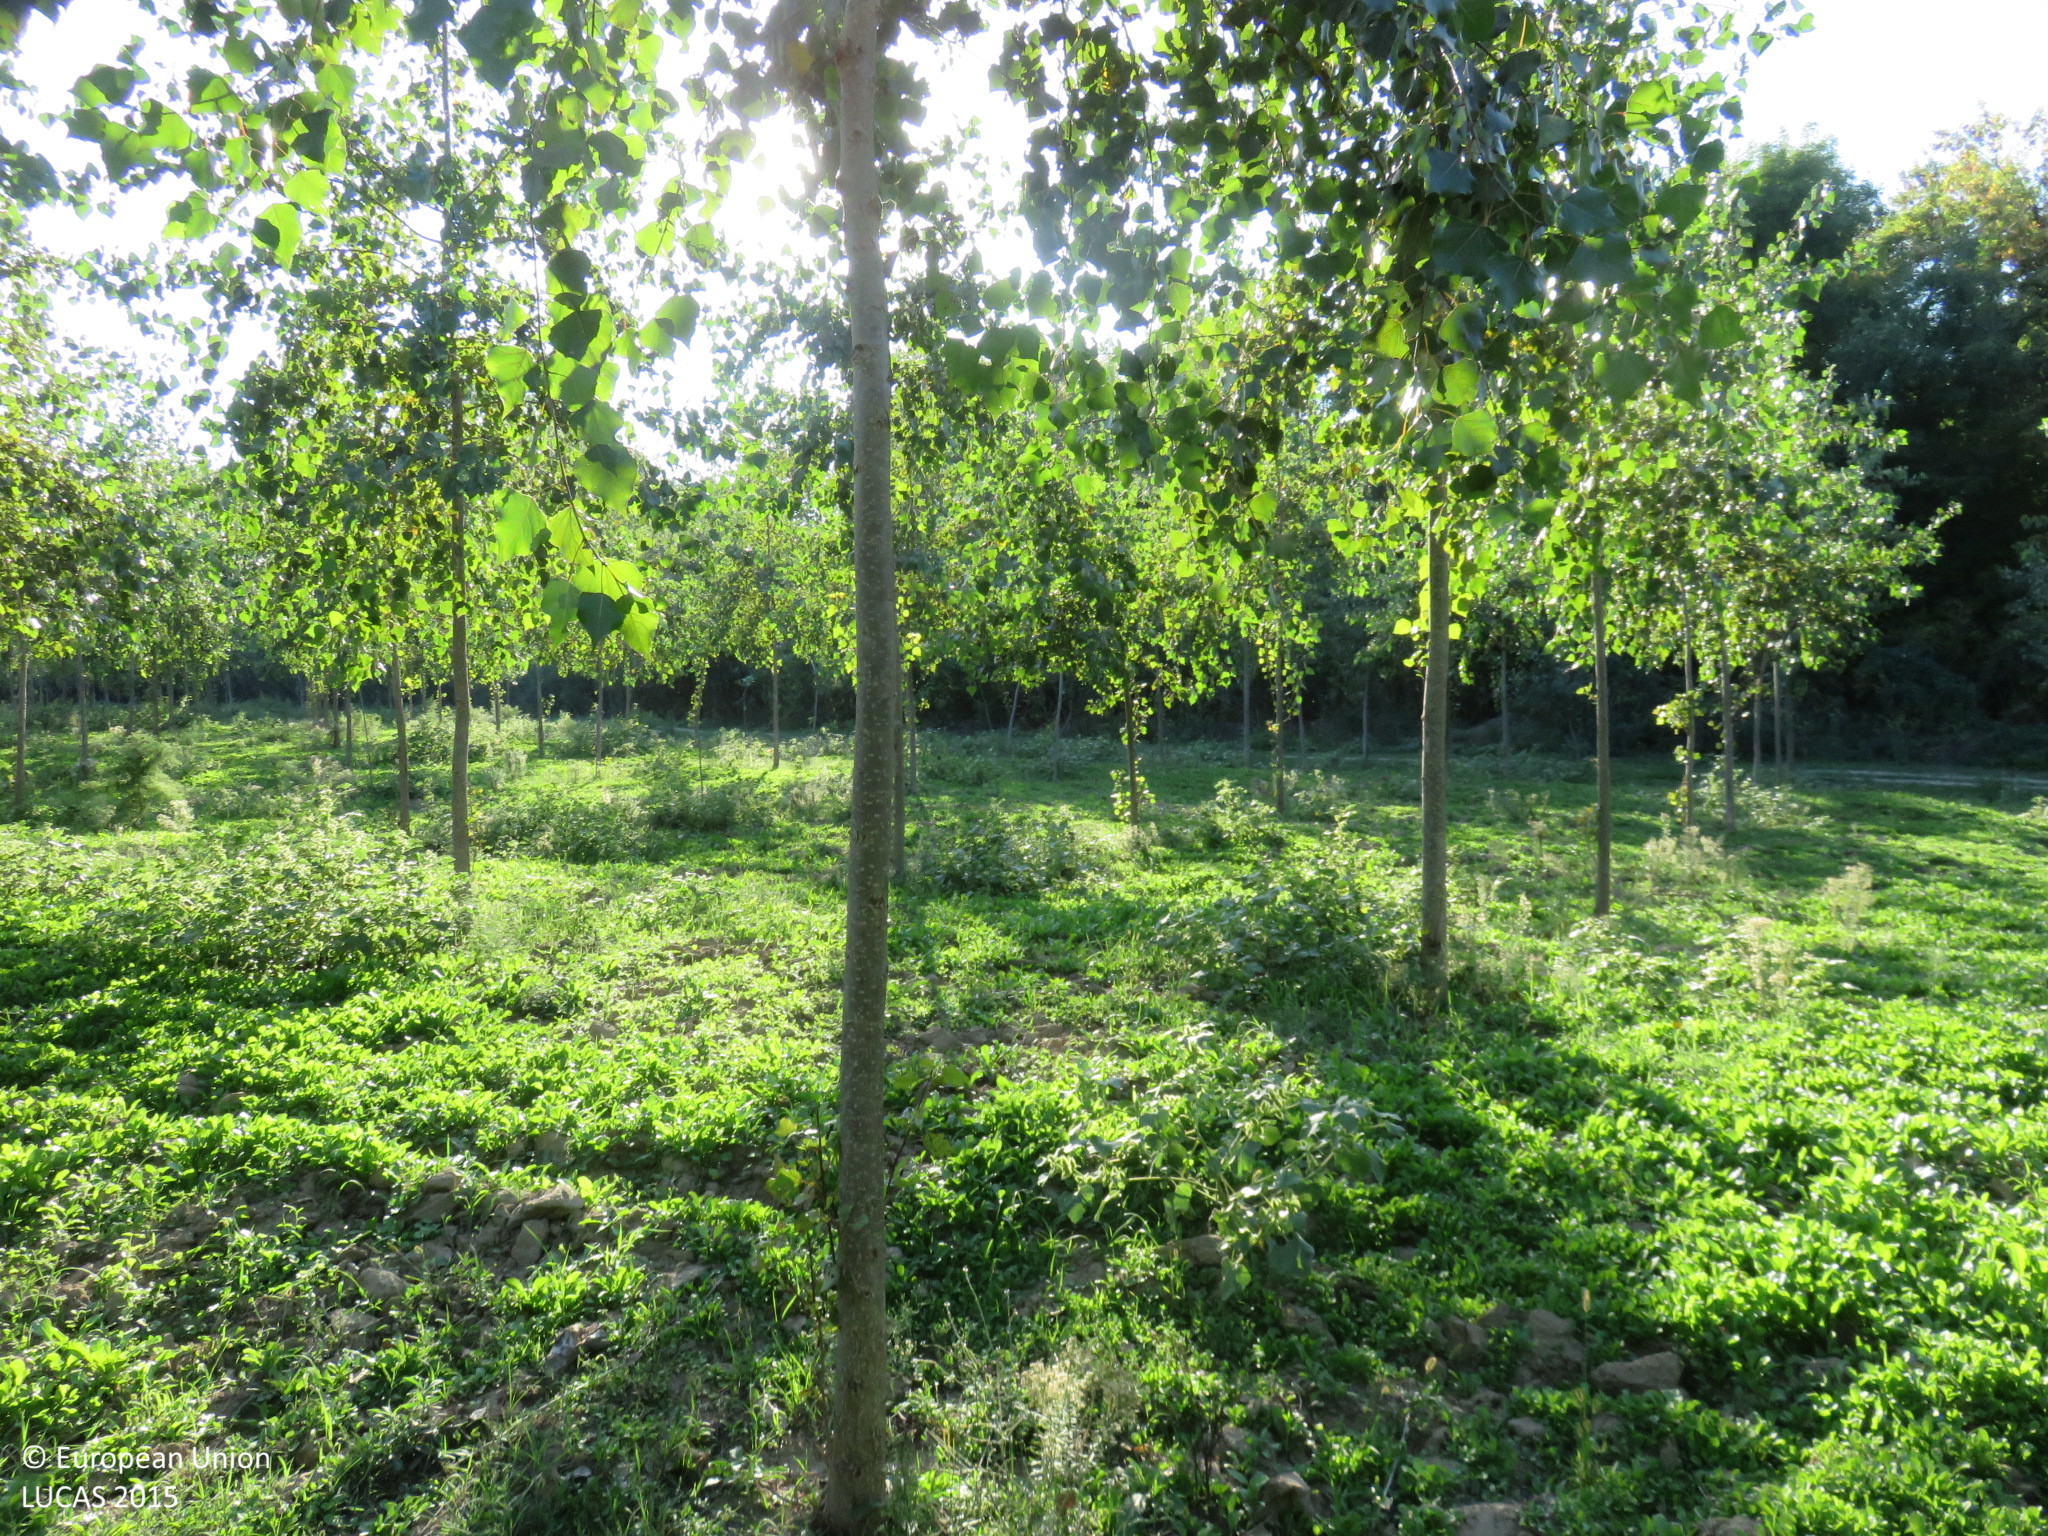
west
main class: Woodland
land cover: Broadleaved woodland
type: floodplain forest
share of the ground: 50 - 75 %
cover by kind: broadleaved forest trees 60 %, herbaceous plants 40 %
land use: Forestry
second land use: Protection infrastructures
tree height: < 5 m
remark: Nursery
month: September
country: BG
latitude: 43.7140
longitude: 24.9791
